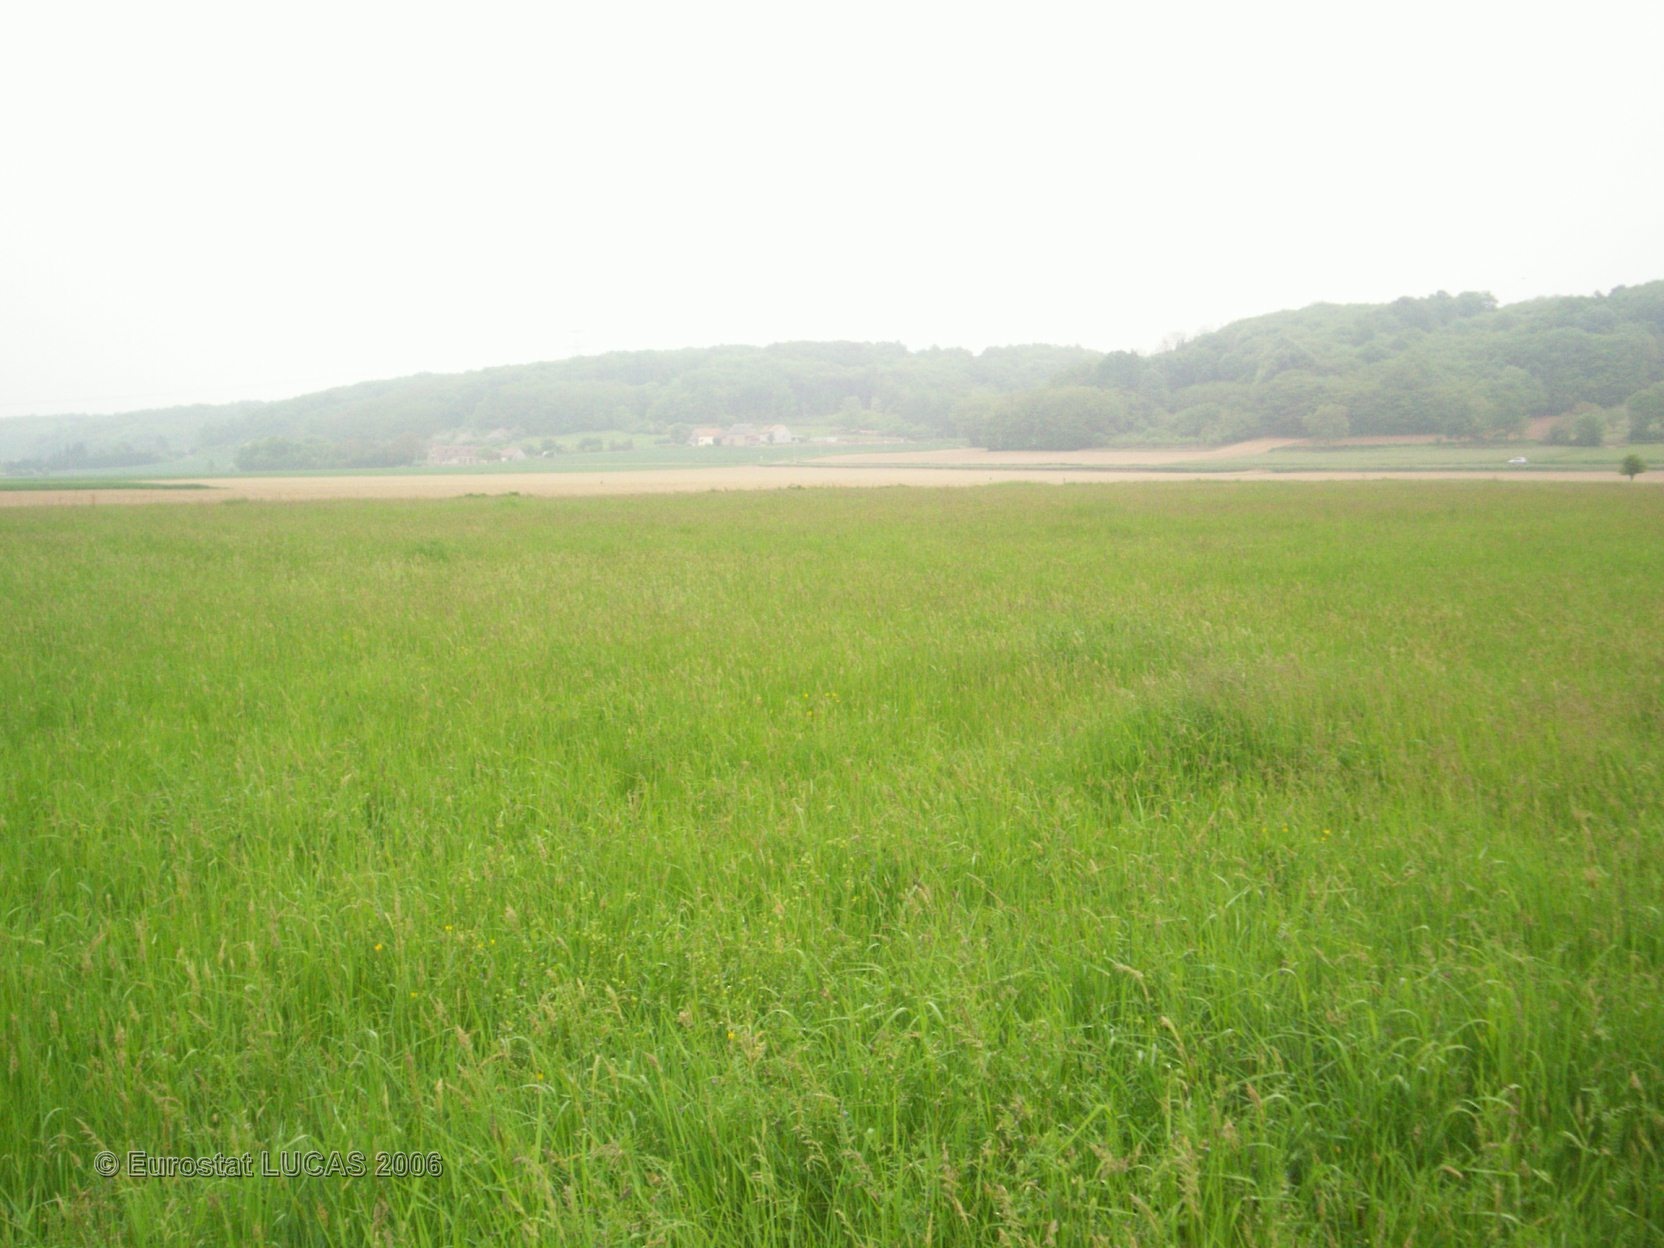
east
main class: Grassland
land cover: Grassland without tree/shrub cover
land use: Agriculture (excluding fallow land and kitchen gardens)
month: May
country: FR
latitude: 47.6838
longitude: 0.4793
